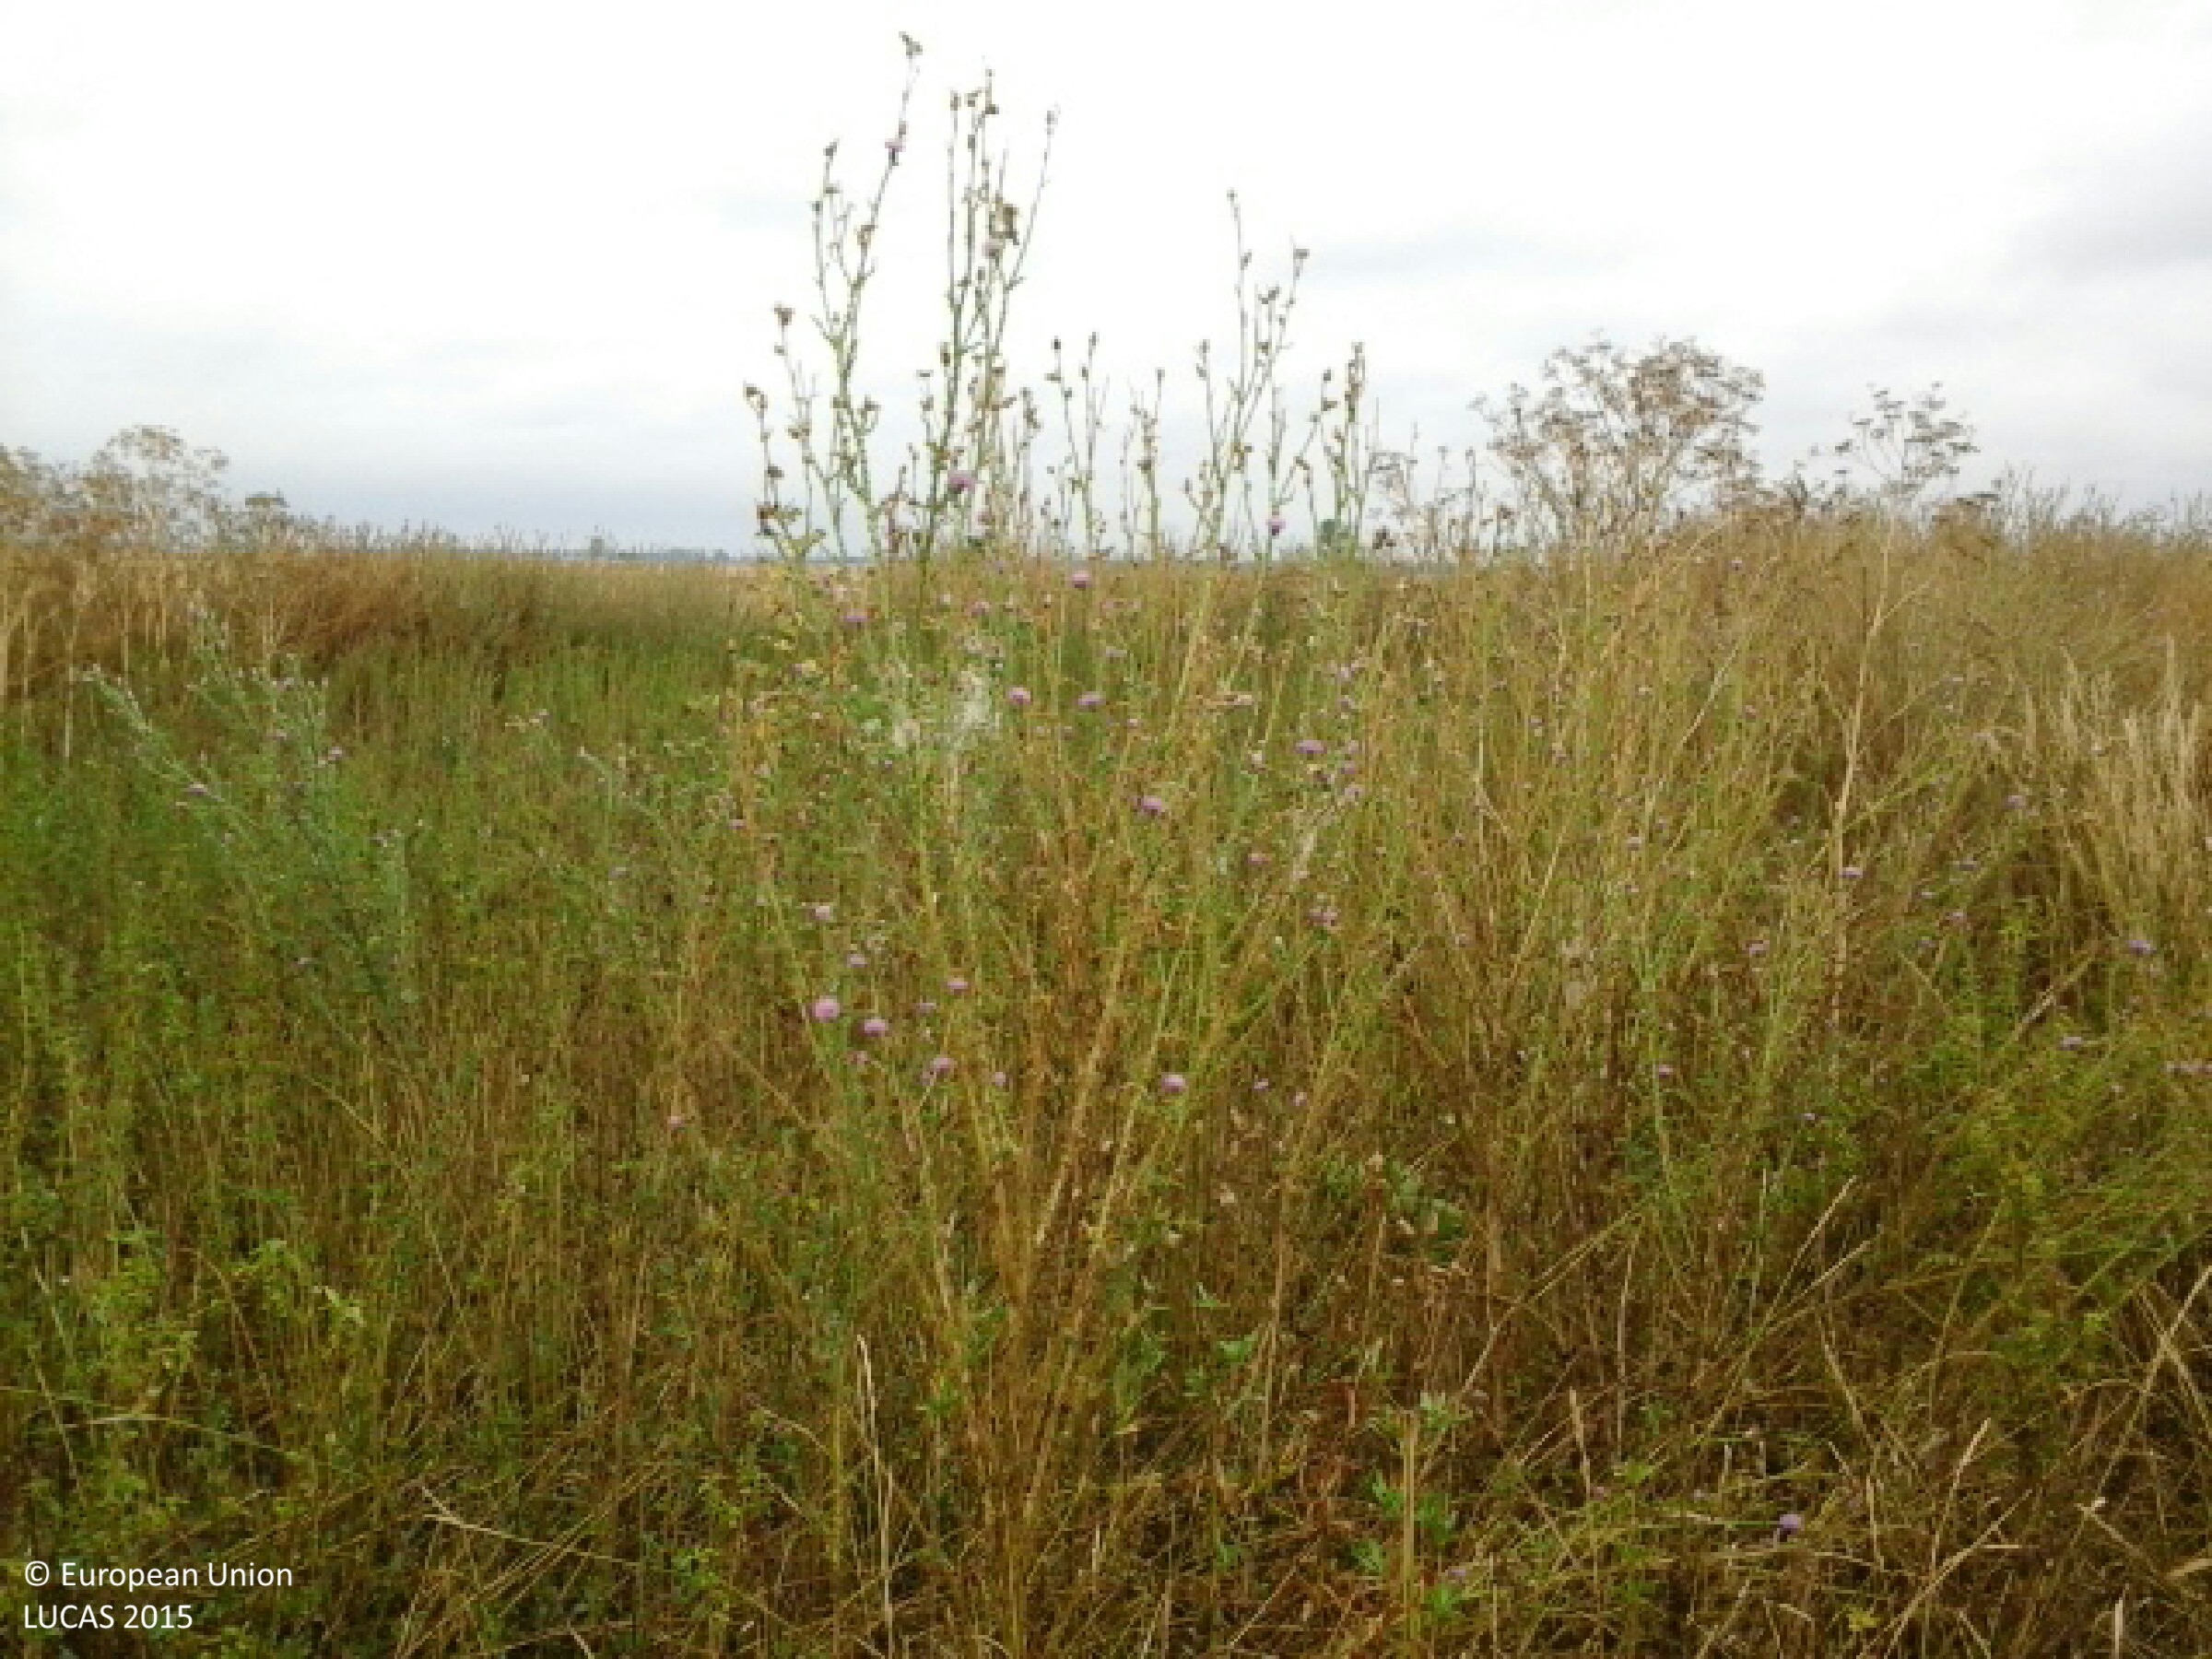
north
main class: Grassland
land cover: Spontaneously vegetated surfaces
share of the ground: > 75 %
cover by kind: herbaceous plants 100 %
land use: Semi-natural and natural areas not in use
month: August
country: HU
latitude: 47.1562
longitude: 21.5831
